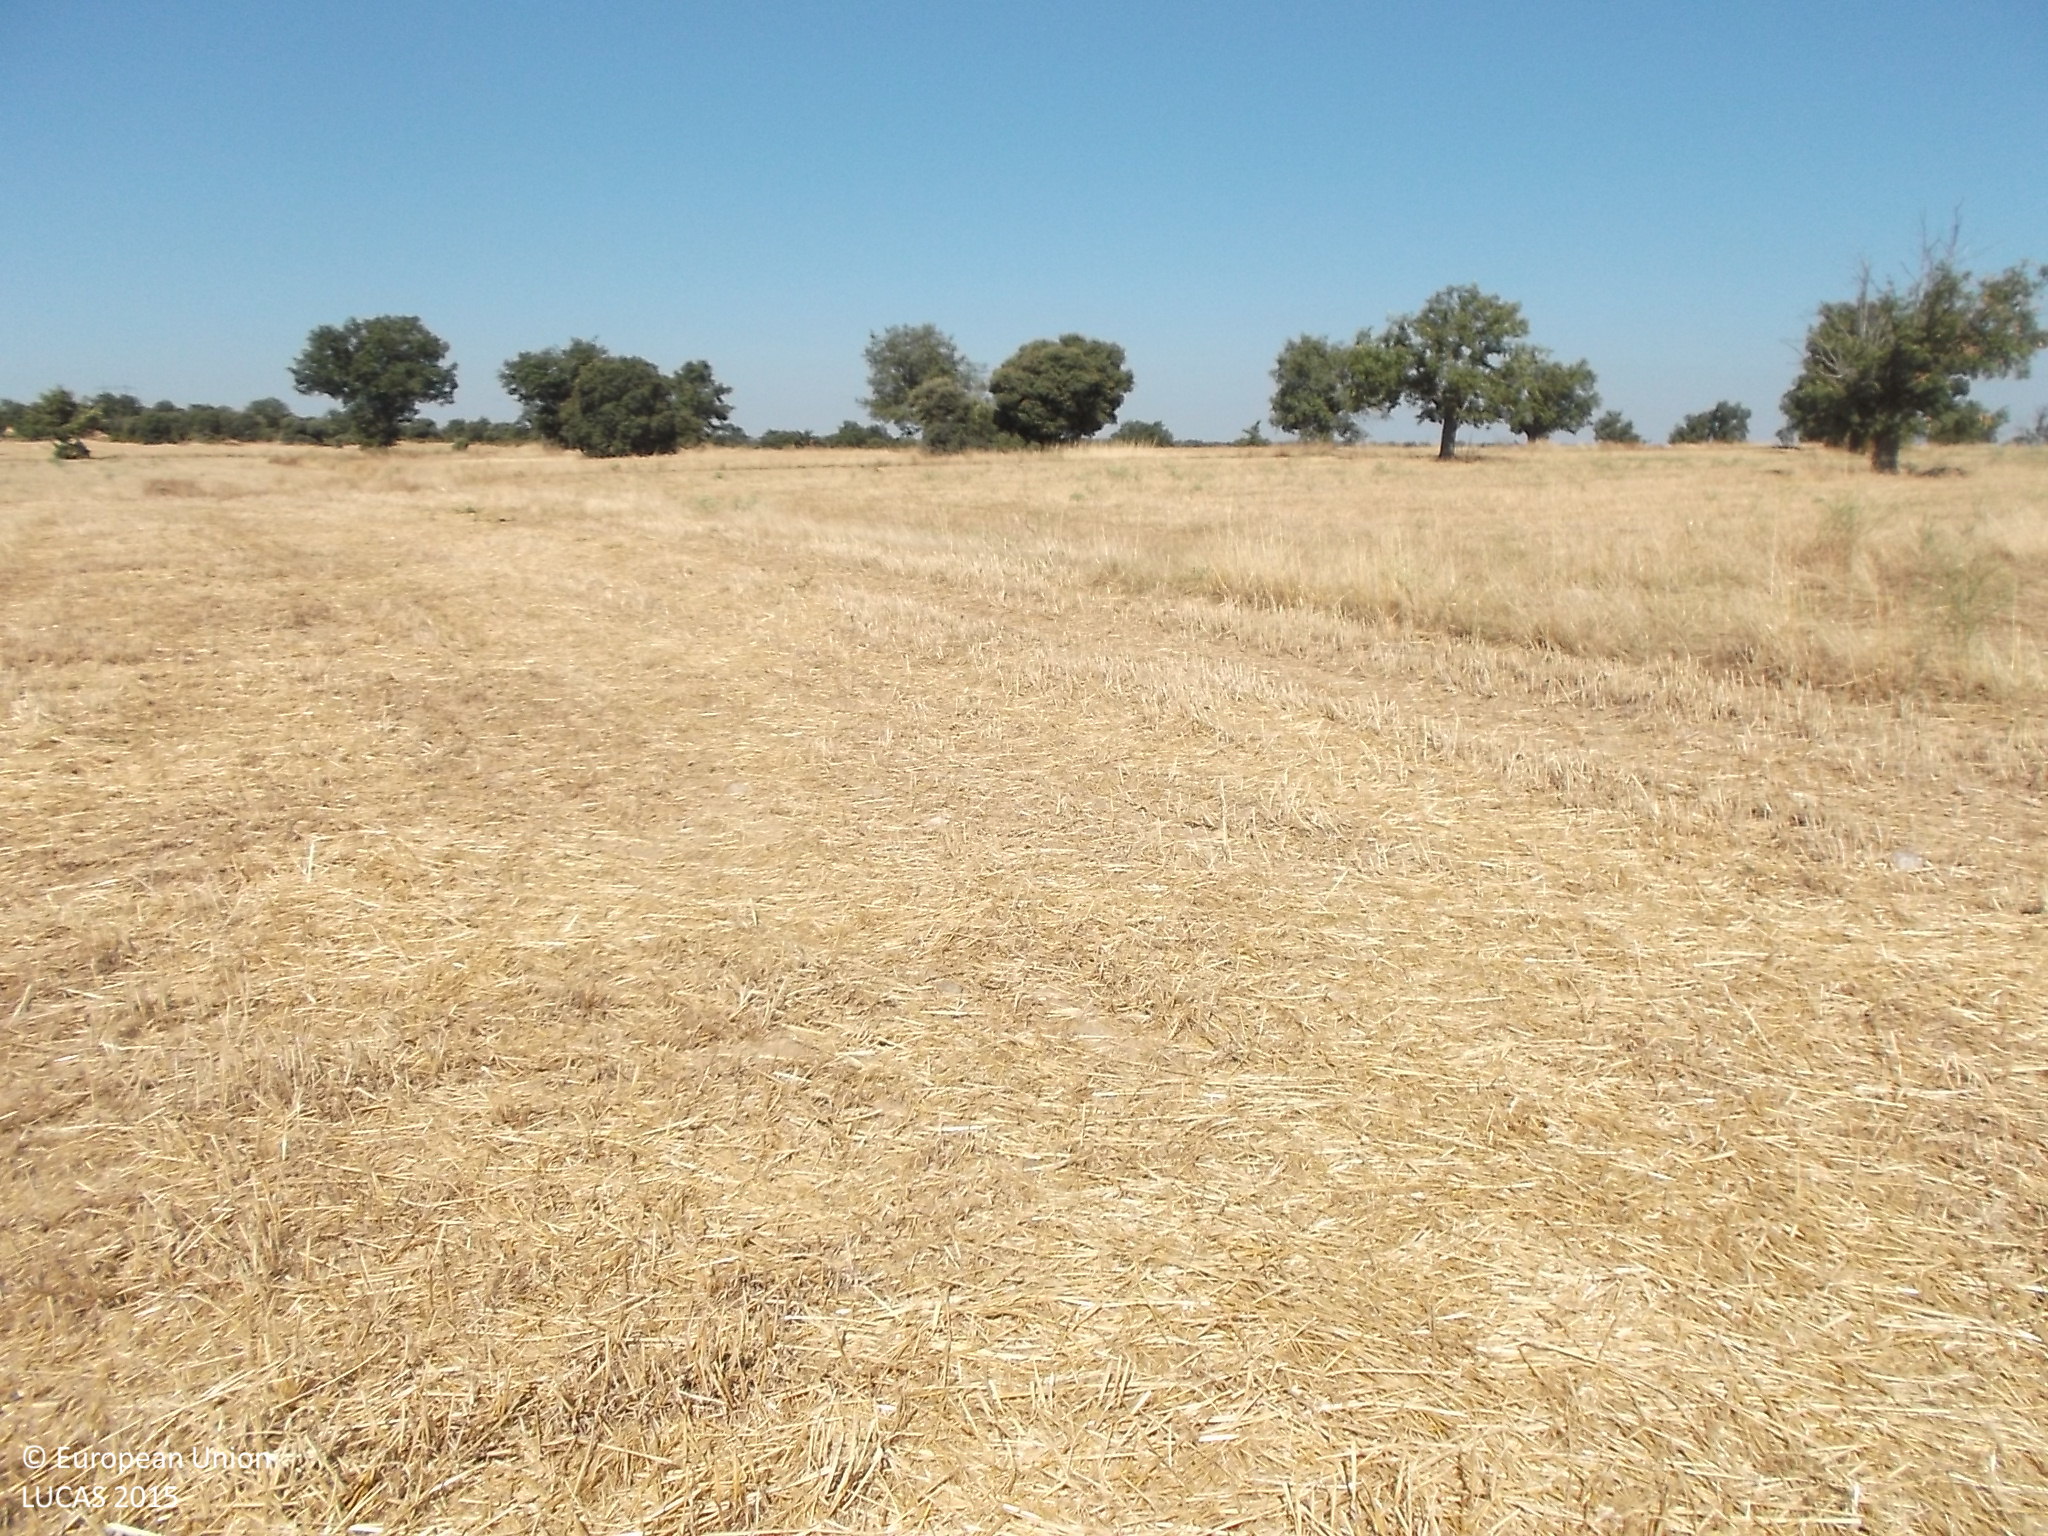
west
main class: Cropland
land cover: Barley
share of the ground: < 10 %
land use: Agriculture (excluding fallow land and kitchen gardens)
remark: Harvested field
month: July
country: ES
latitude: 41.3681
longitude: -6.0267
